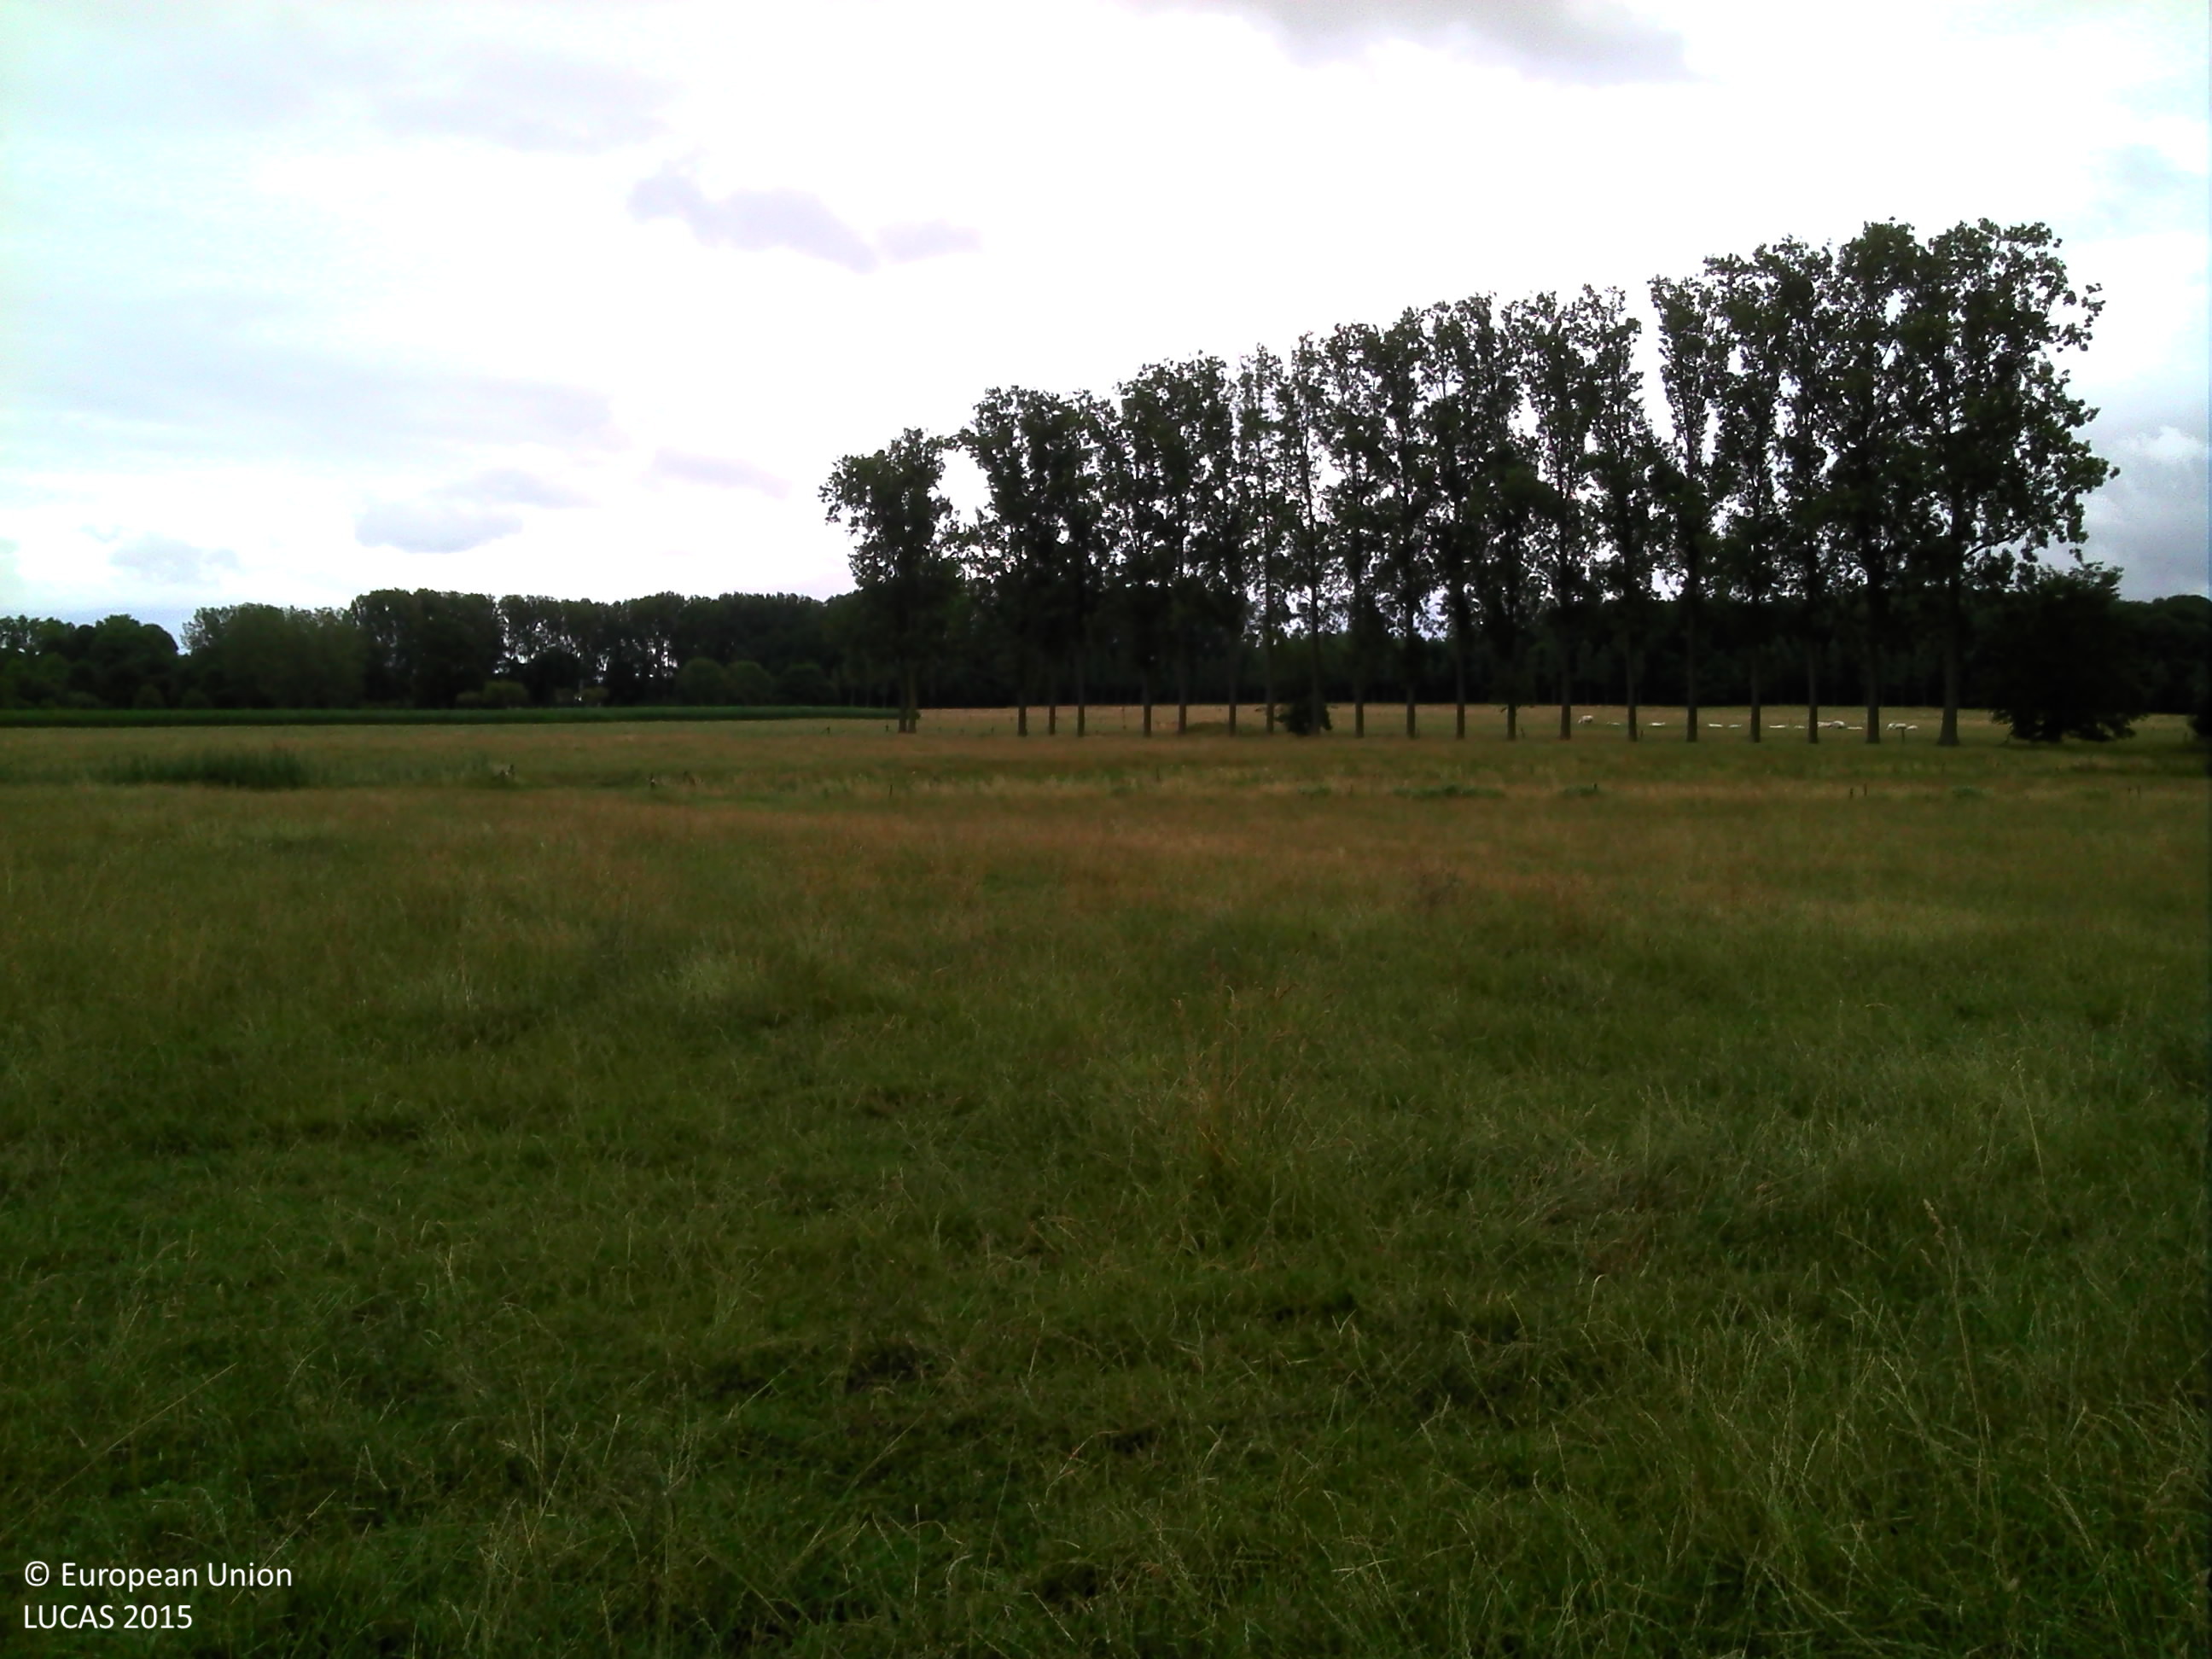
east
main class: Grassland
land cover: Grassland without tree/shrub cover
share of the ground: > 75 %
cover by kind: herbaceous plants 100 %
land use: Agriculture (excluding fallow land and kitchen gardens)
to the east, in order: Grassland without tree/shrub cover; Fences; Ditches and canals; Fences; Grassland without tree/shrub cover; Fences; Ditches and canals; Fences; Grassland without tree/shrub cover; Lines of trees; Grass margins; Fences; Grassland without tree/shrub cover
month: July
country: BE
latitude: 50.8685
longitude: 5.4653
